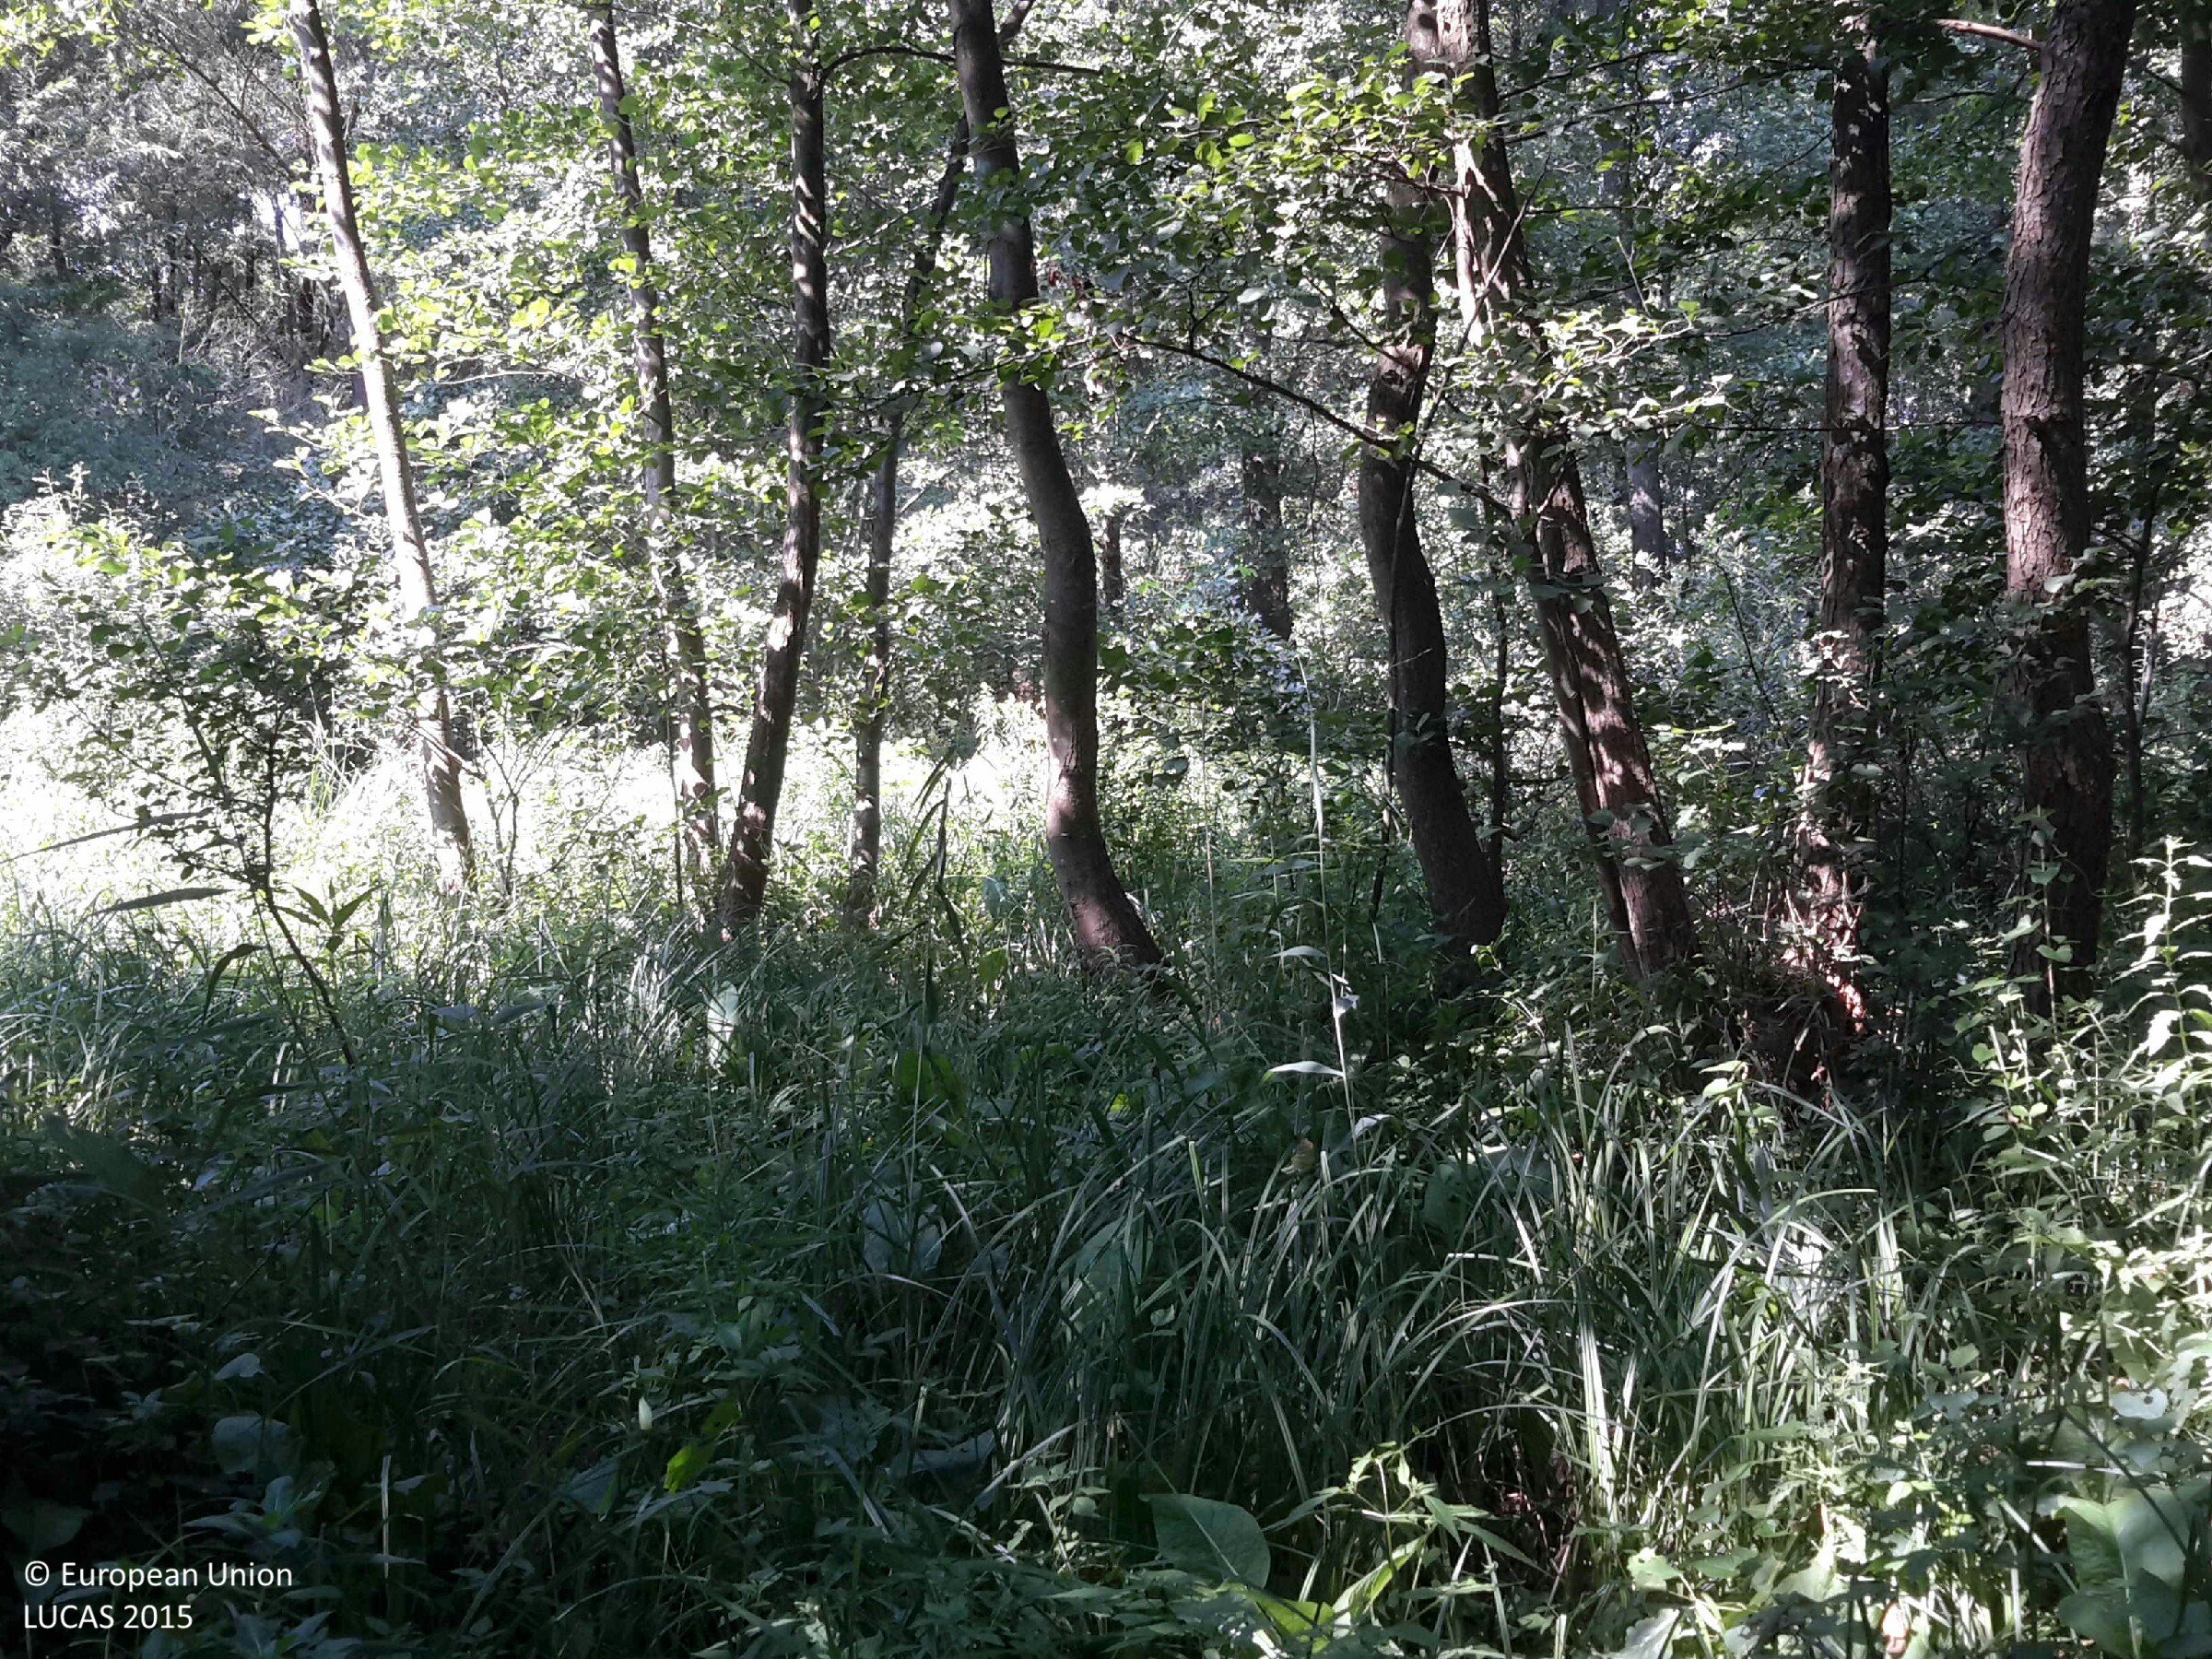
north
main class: Woodland
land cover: Broadleaved woodland
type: mesophytic deciduous forest
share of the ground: > 75 %
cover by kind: broadleaved forest trees 90 %, herbaceous plants 10 %
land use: Forestry
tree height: > 5 m
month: August
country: HU
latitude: 47.8017
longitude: 17.2845
